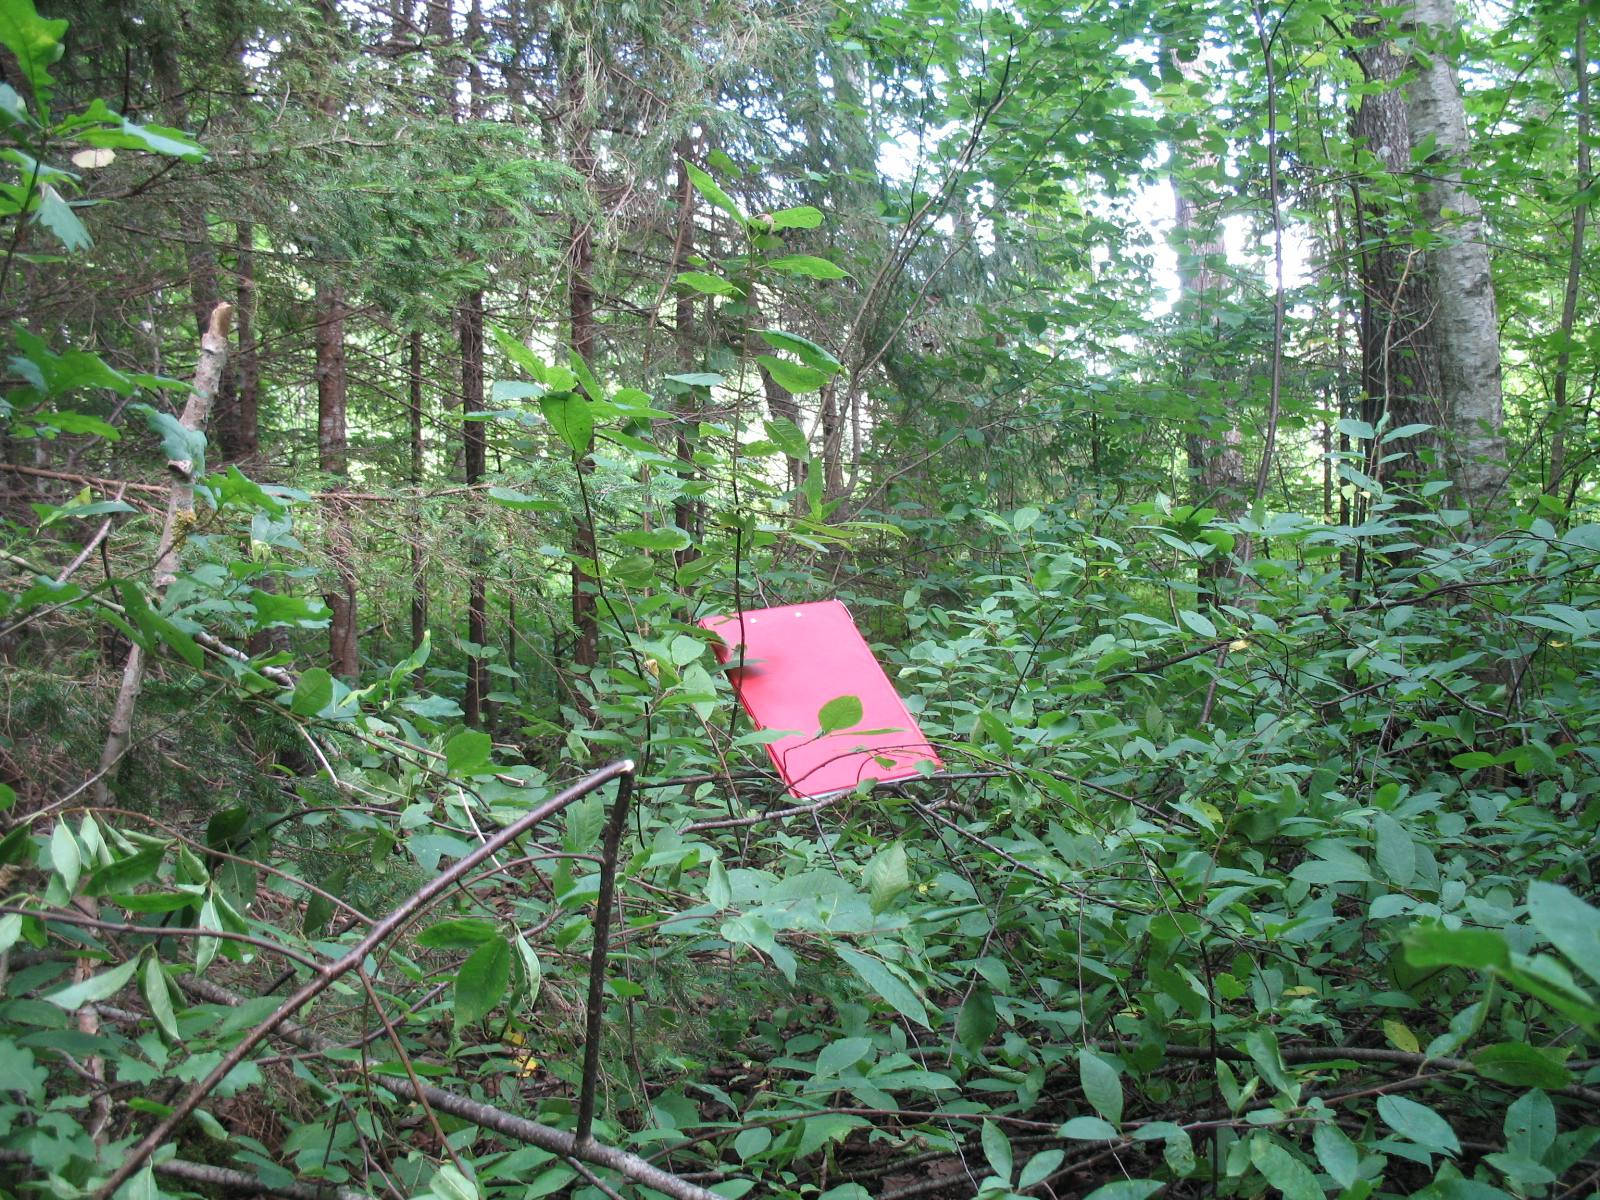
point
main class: Woodland
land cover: Spruce dominated mixed woodland
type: hemiboreal forest and nemoral coniferous forest and mixed broadleaved-coniferous forest
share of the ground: > 75 %
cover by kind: broadleaved forest trees 55 %, coniferous forest trees 35 %, shrubs 5 %, herbaceous plants 5 %
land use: Forestry
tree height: > 5 m
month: July
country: LV
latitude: 56.3000
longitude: 25.0582
